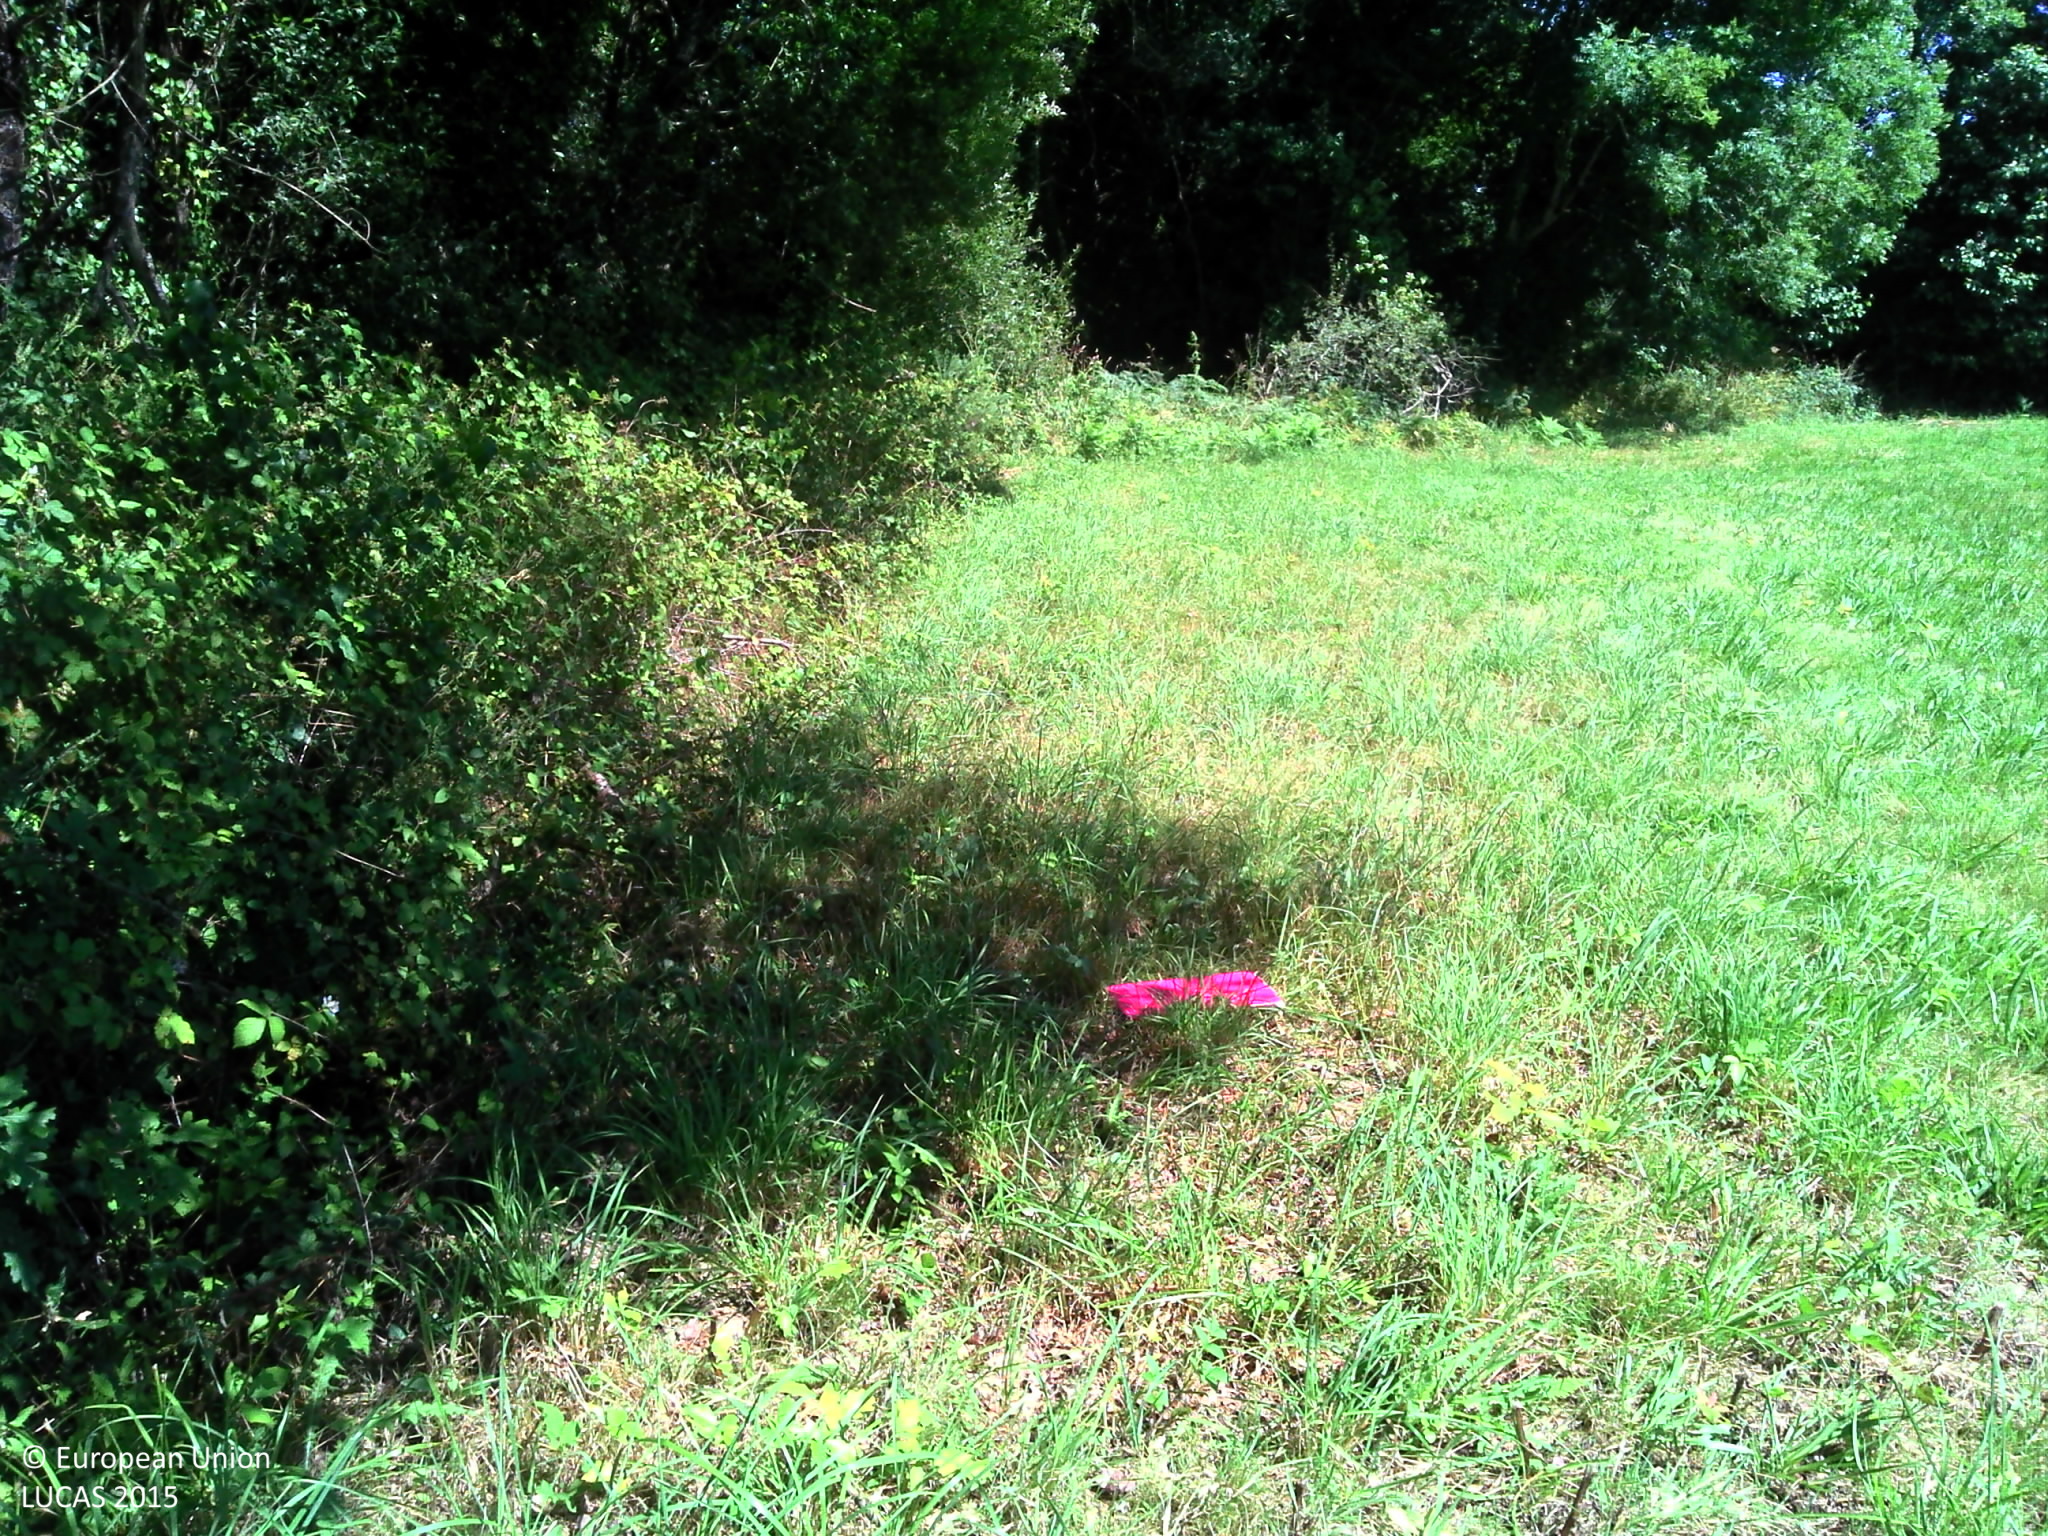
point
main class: Grassland
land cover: Grassland without tree/shrub cover
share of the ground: > 75 %
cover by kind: herbaceous plants 100 %
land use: Agriculture (excluding fallow land and kitchen gardens)
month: July
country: FR
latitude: 47.7250
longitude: -2.0368
